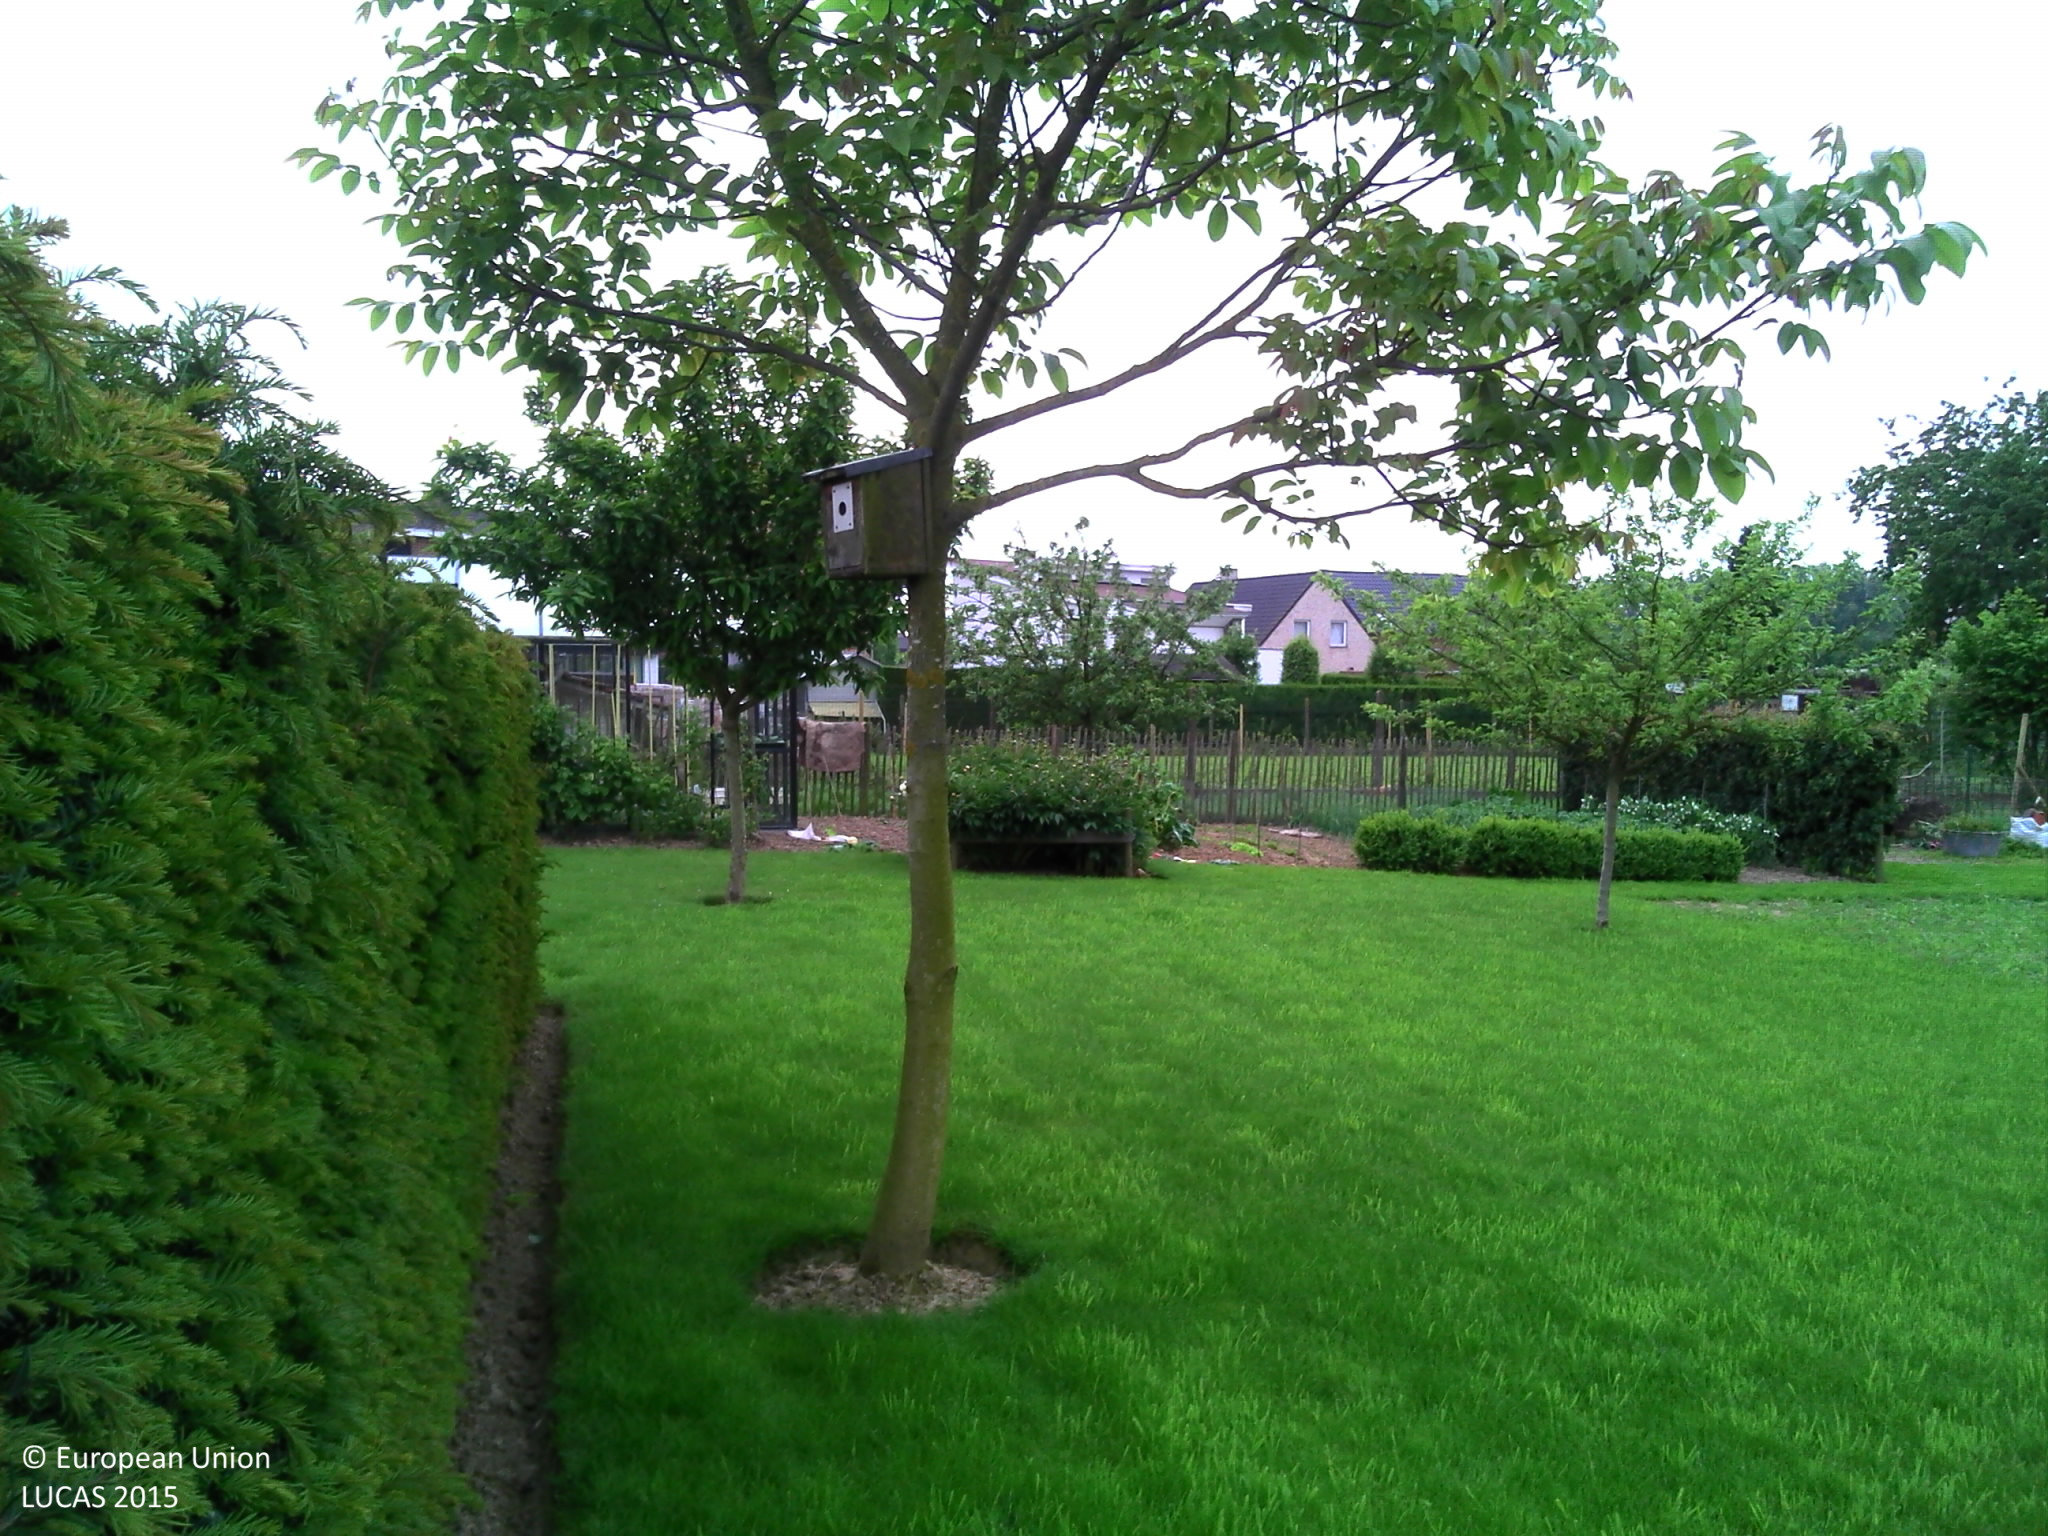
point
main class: Grassland
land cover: Grassland without tree/shrub cover
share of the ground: > 75 %
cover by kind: herbaceous plants 95 %, shrubs 5 %
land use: Residential
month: May
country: BE
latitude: 50.7460
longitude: 3.9708
